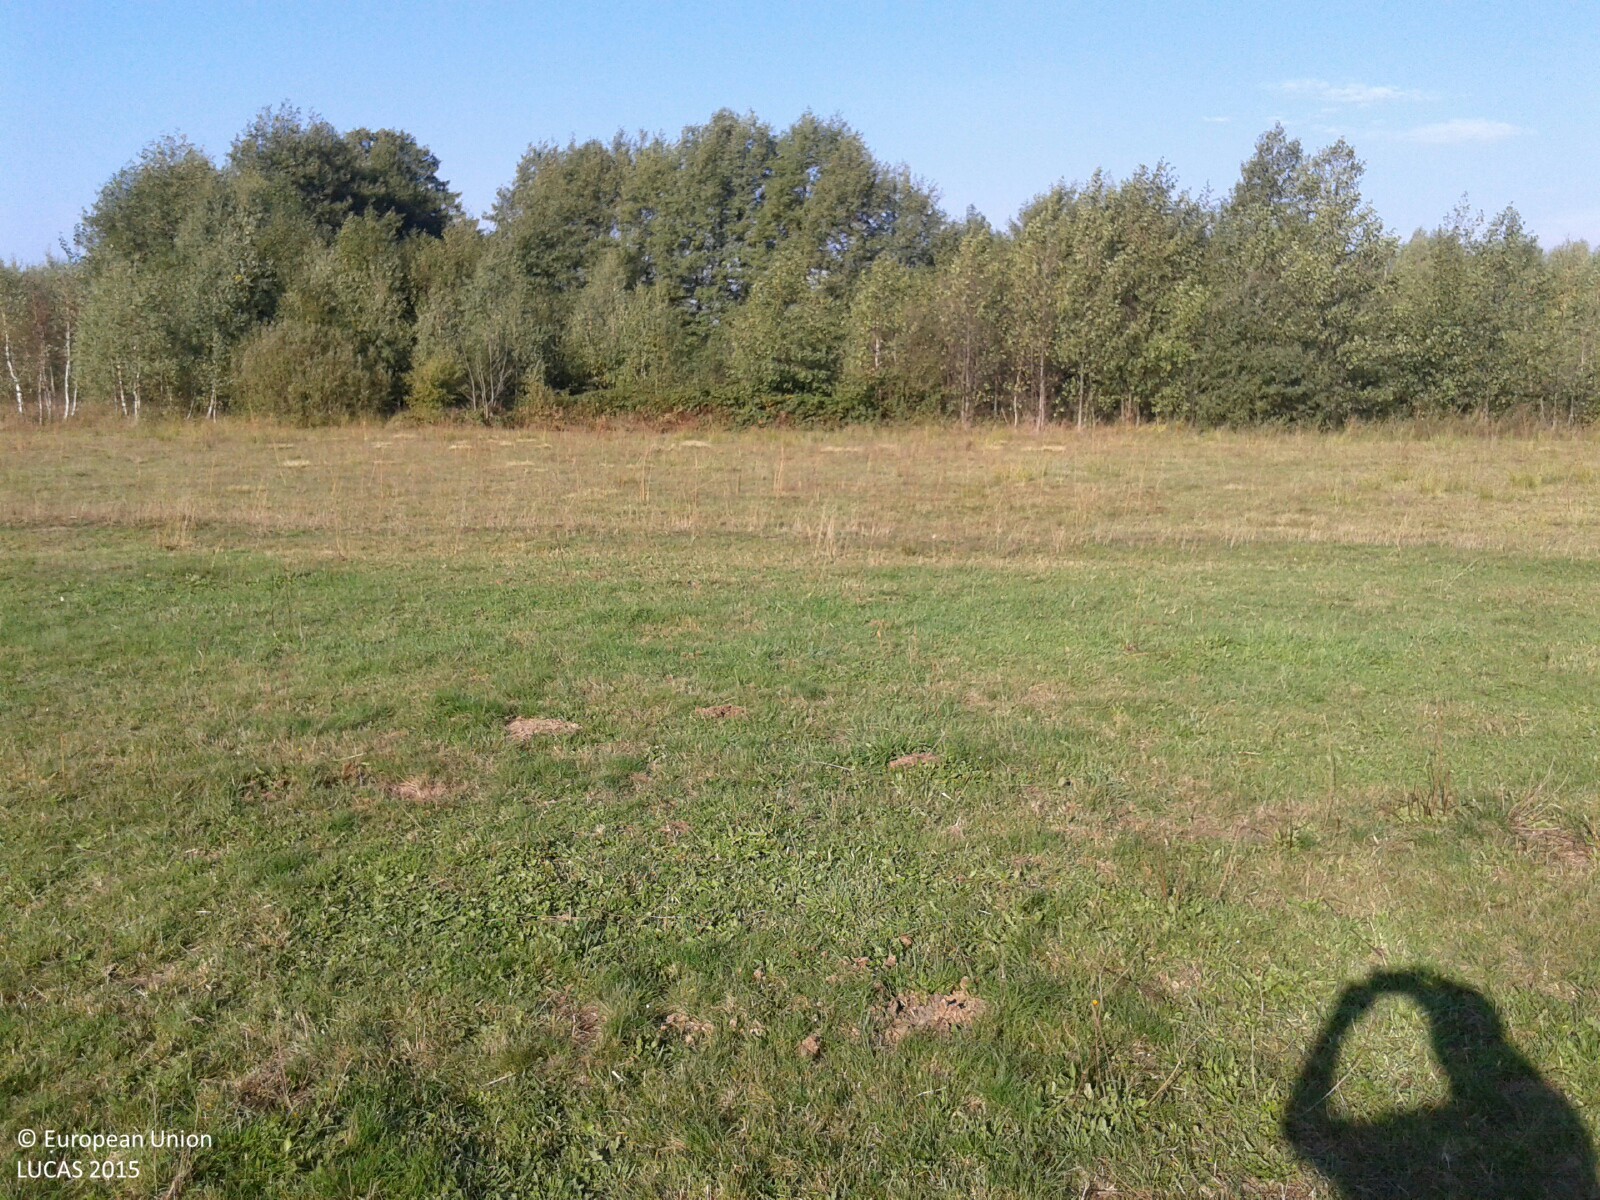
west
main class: Grassland
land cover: Grassland without tree/shrub cover
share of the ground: > 75 %
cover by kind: herbaceous plants 95 %, unconsolidated bare surface 5 %
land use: Agriculture (excluding fallow land and kitchen gardens)
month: September
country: PL
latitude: 52.6258
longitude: 21.9497
